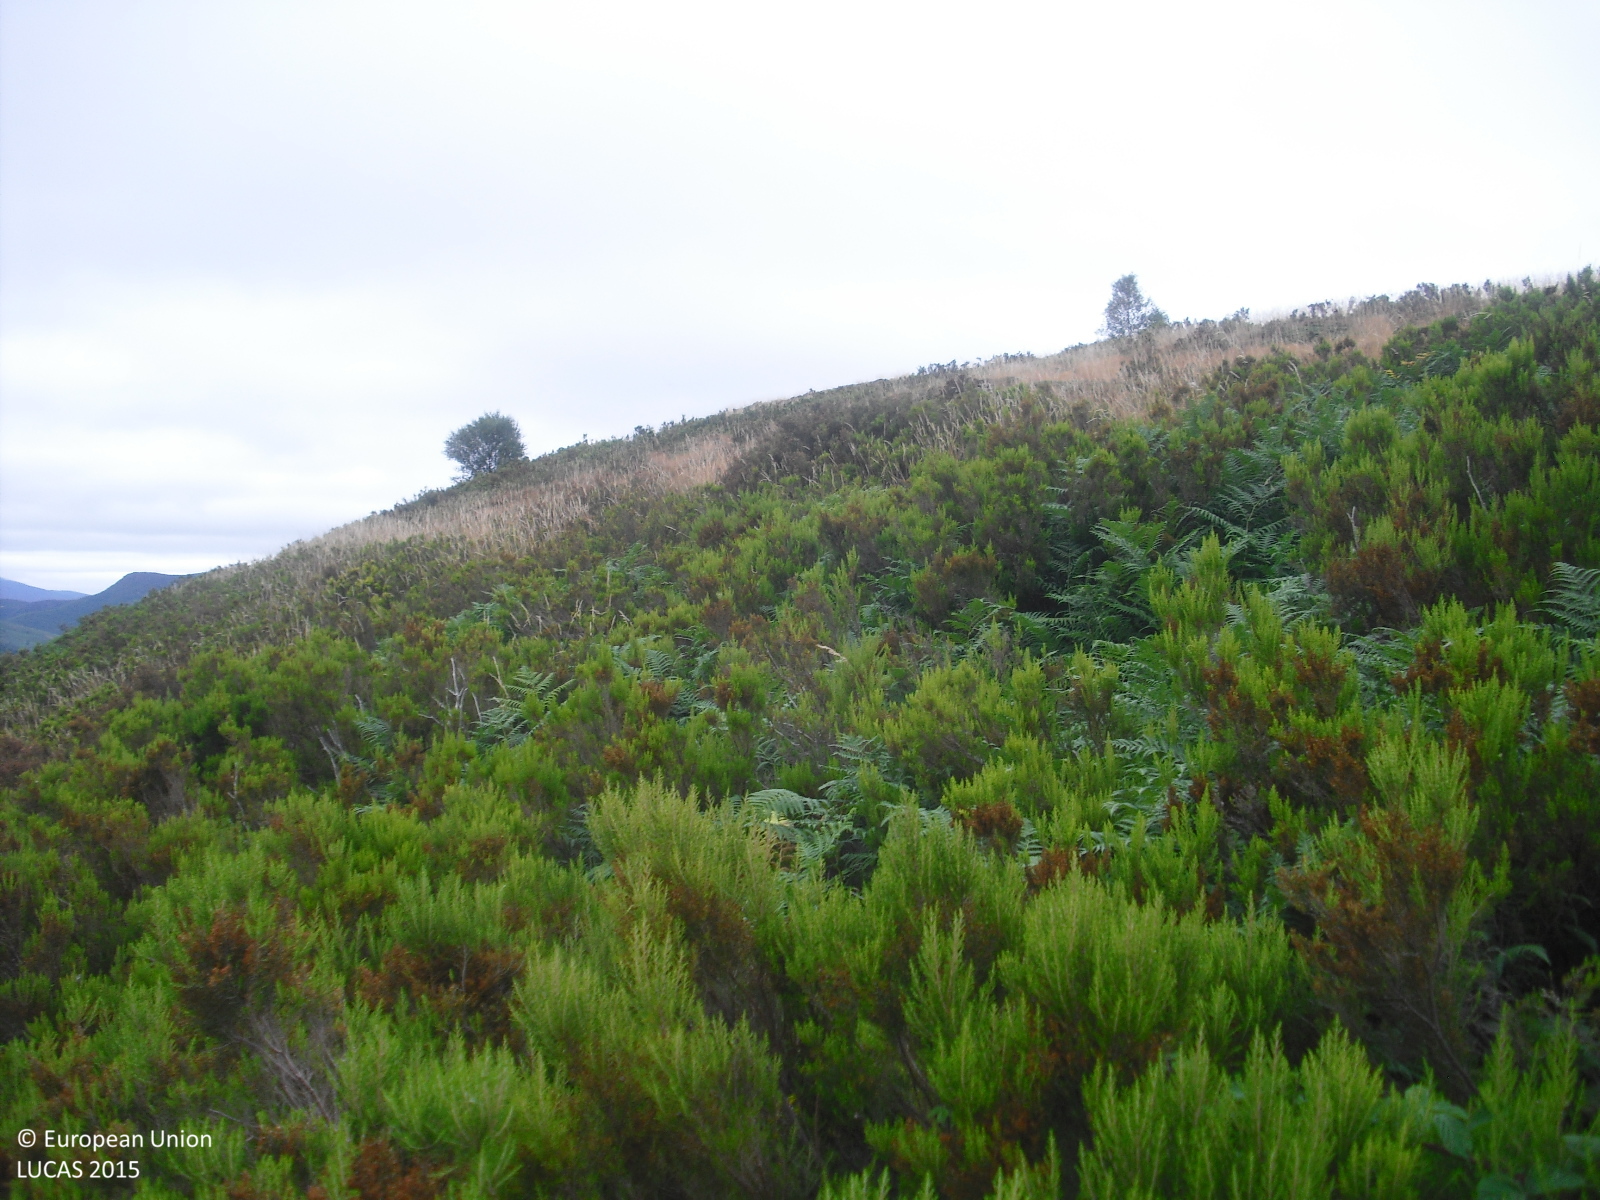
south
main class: Shrubland
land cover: Shrubland without tree cover
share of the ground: > 75 %
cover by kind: shrubs 100 %
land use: Agriculture (excluding fallow land and kitchen gardens)
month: July
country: ES
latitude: 42.7095
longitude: -7.2435
